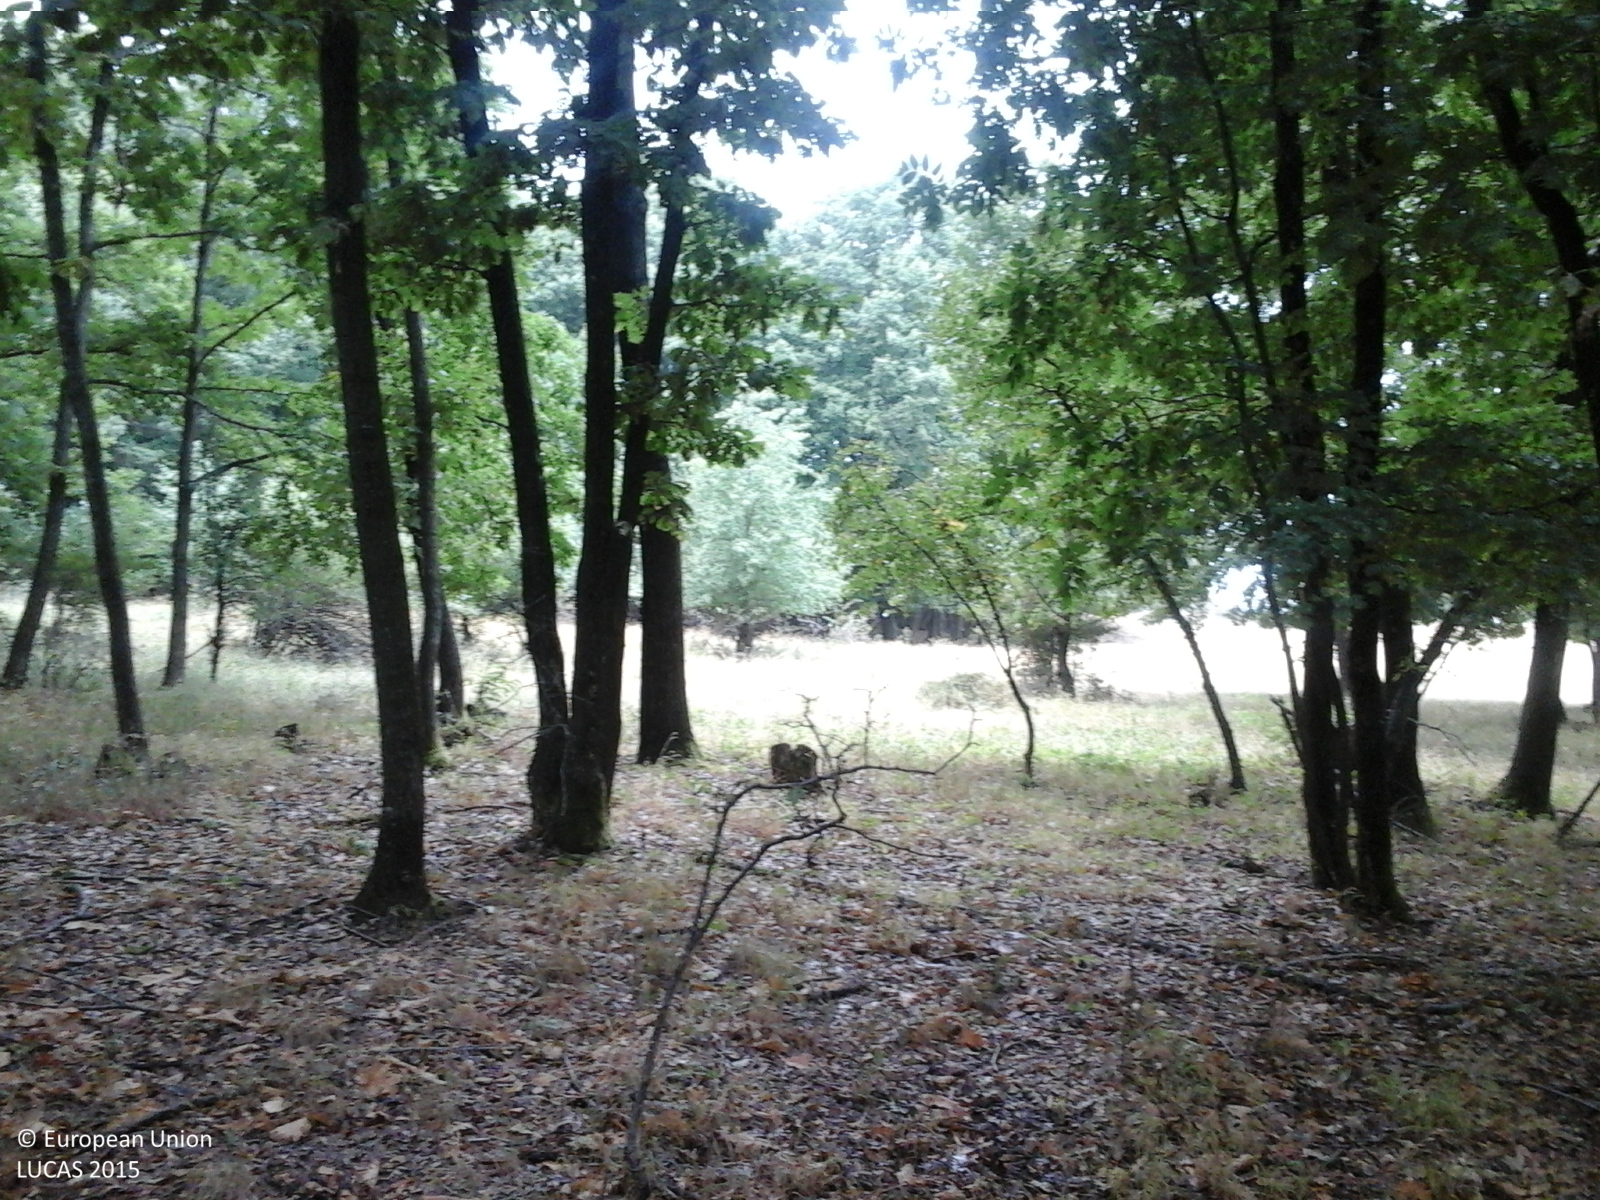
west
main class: Woodland
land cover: Broadleaved woodland
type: acidophilous oak and oak-birch forest
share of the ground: > 75 %
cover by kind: broadleaved forest trees 100 %
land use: Forestry
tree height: > 5 m
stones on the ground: < 10 %
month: August
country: RO
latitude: 44.6050
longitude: 22.8580
